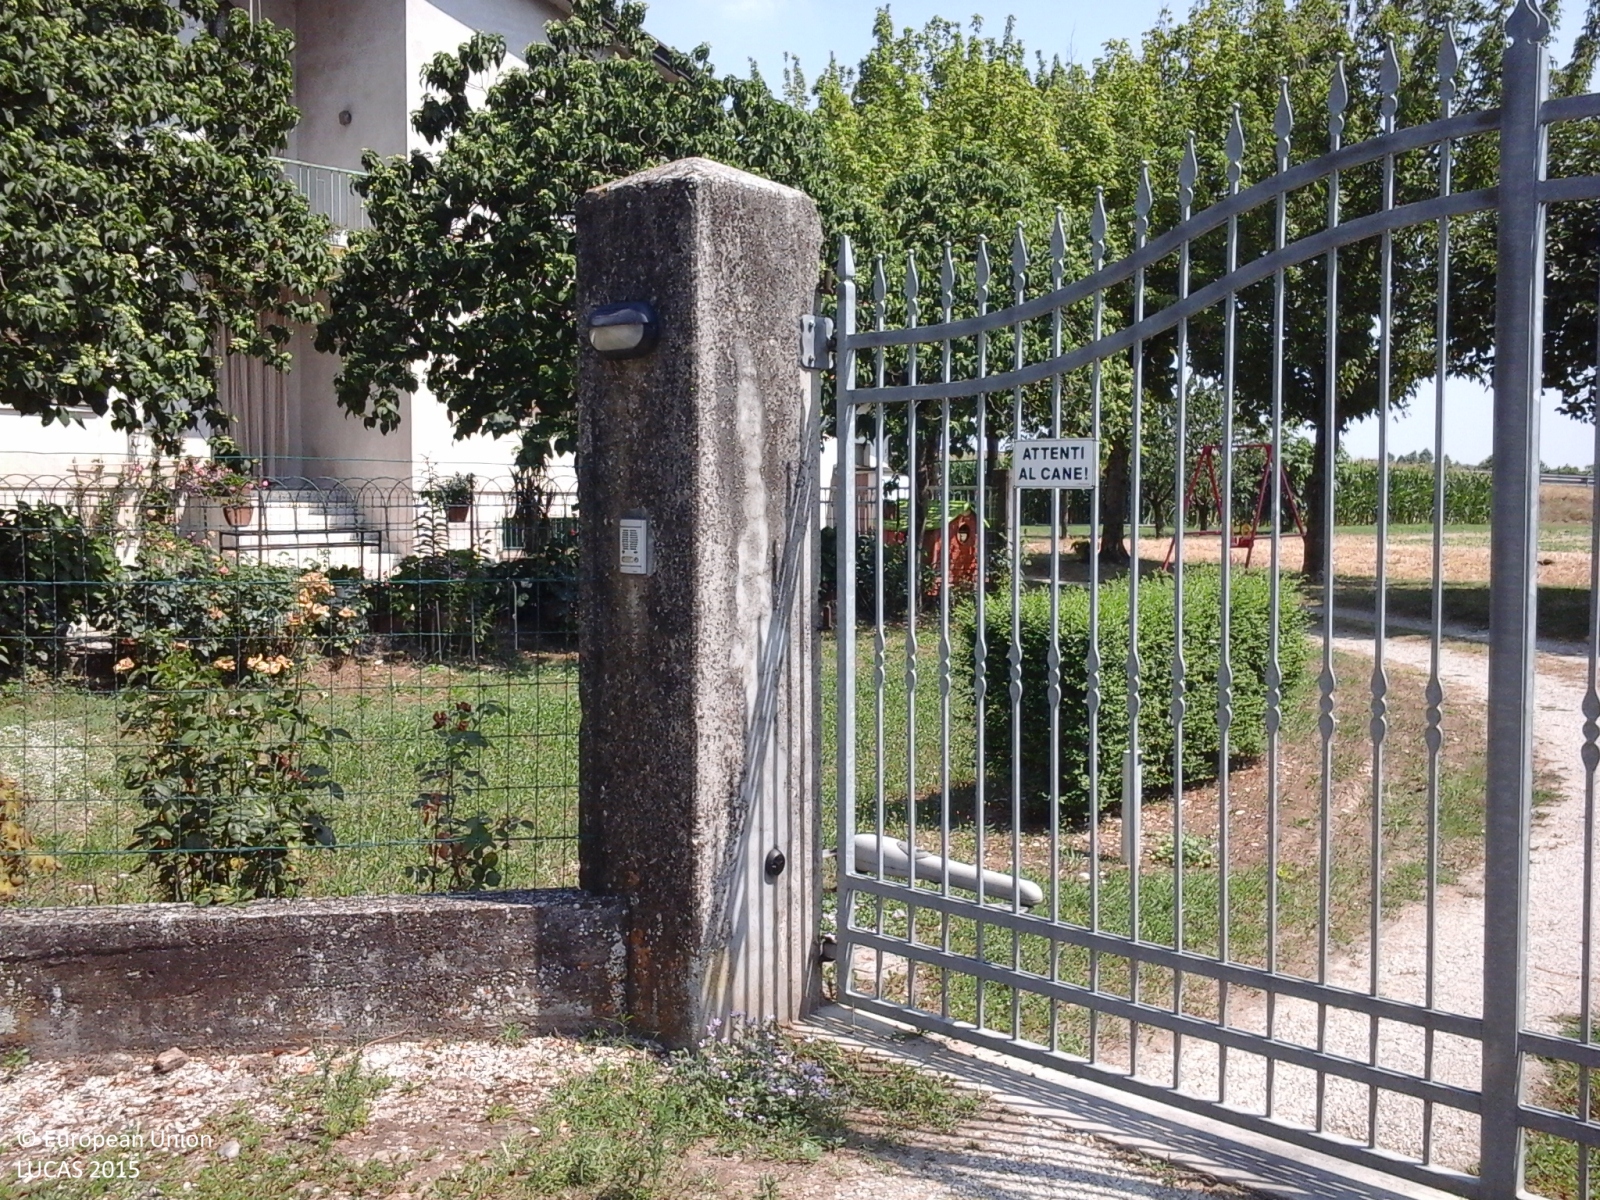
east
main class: Shrubland
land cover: Shrubland without tree cover
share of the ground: > 75 %
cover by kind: shrubs 90 %, herbaceous plants 10 %
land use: Residential
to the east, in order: Shrubland without tree cover; Artificial constructions in urban areas; Common wheat; Grassland without tree/shrub cover; Paved roads, cycling and walking lanes; Grassland without tree/shrub cover; Tracks; Maize; Tracks; Soya; Maize; Tracks; Fences; Ditches and canals; Grassland without tree/shrub cover; Paved roads, cycling and walking lanes
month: June
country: IT
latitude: 45.6958
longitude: 12.2954
